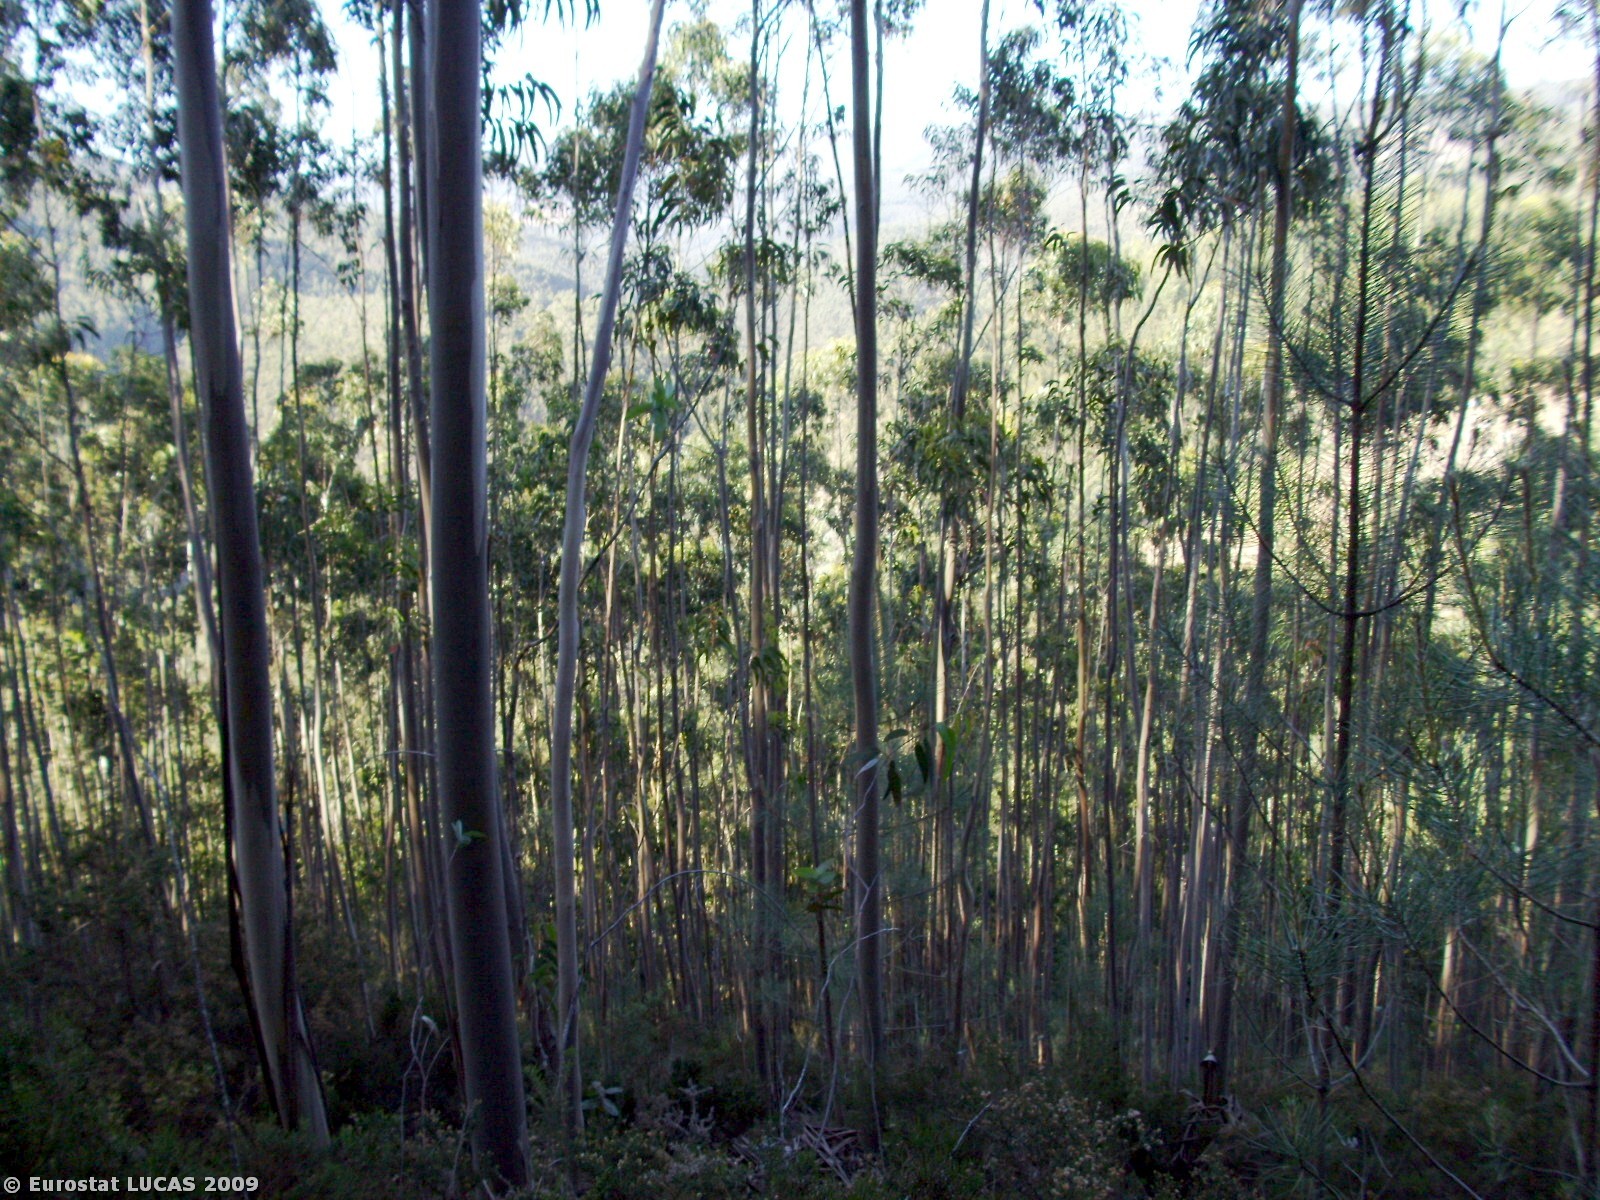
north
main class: Woodland
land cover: Broadleaved woodland
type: plantations and self-sown exotic forest
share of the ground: > 75 %
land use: Forestry
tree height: > 5 m
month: May
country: PT
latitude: 40.7408
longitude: -8.4366
